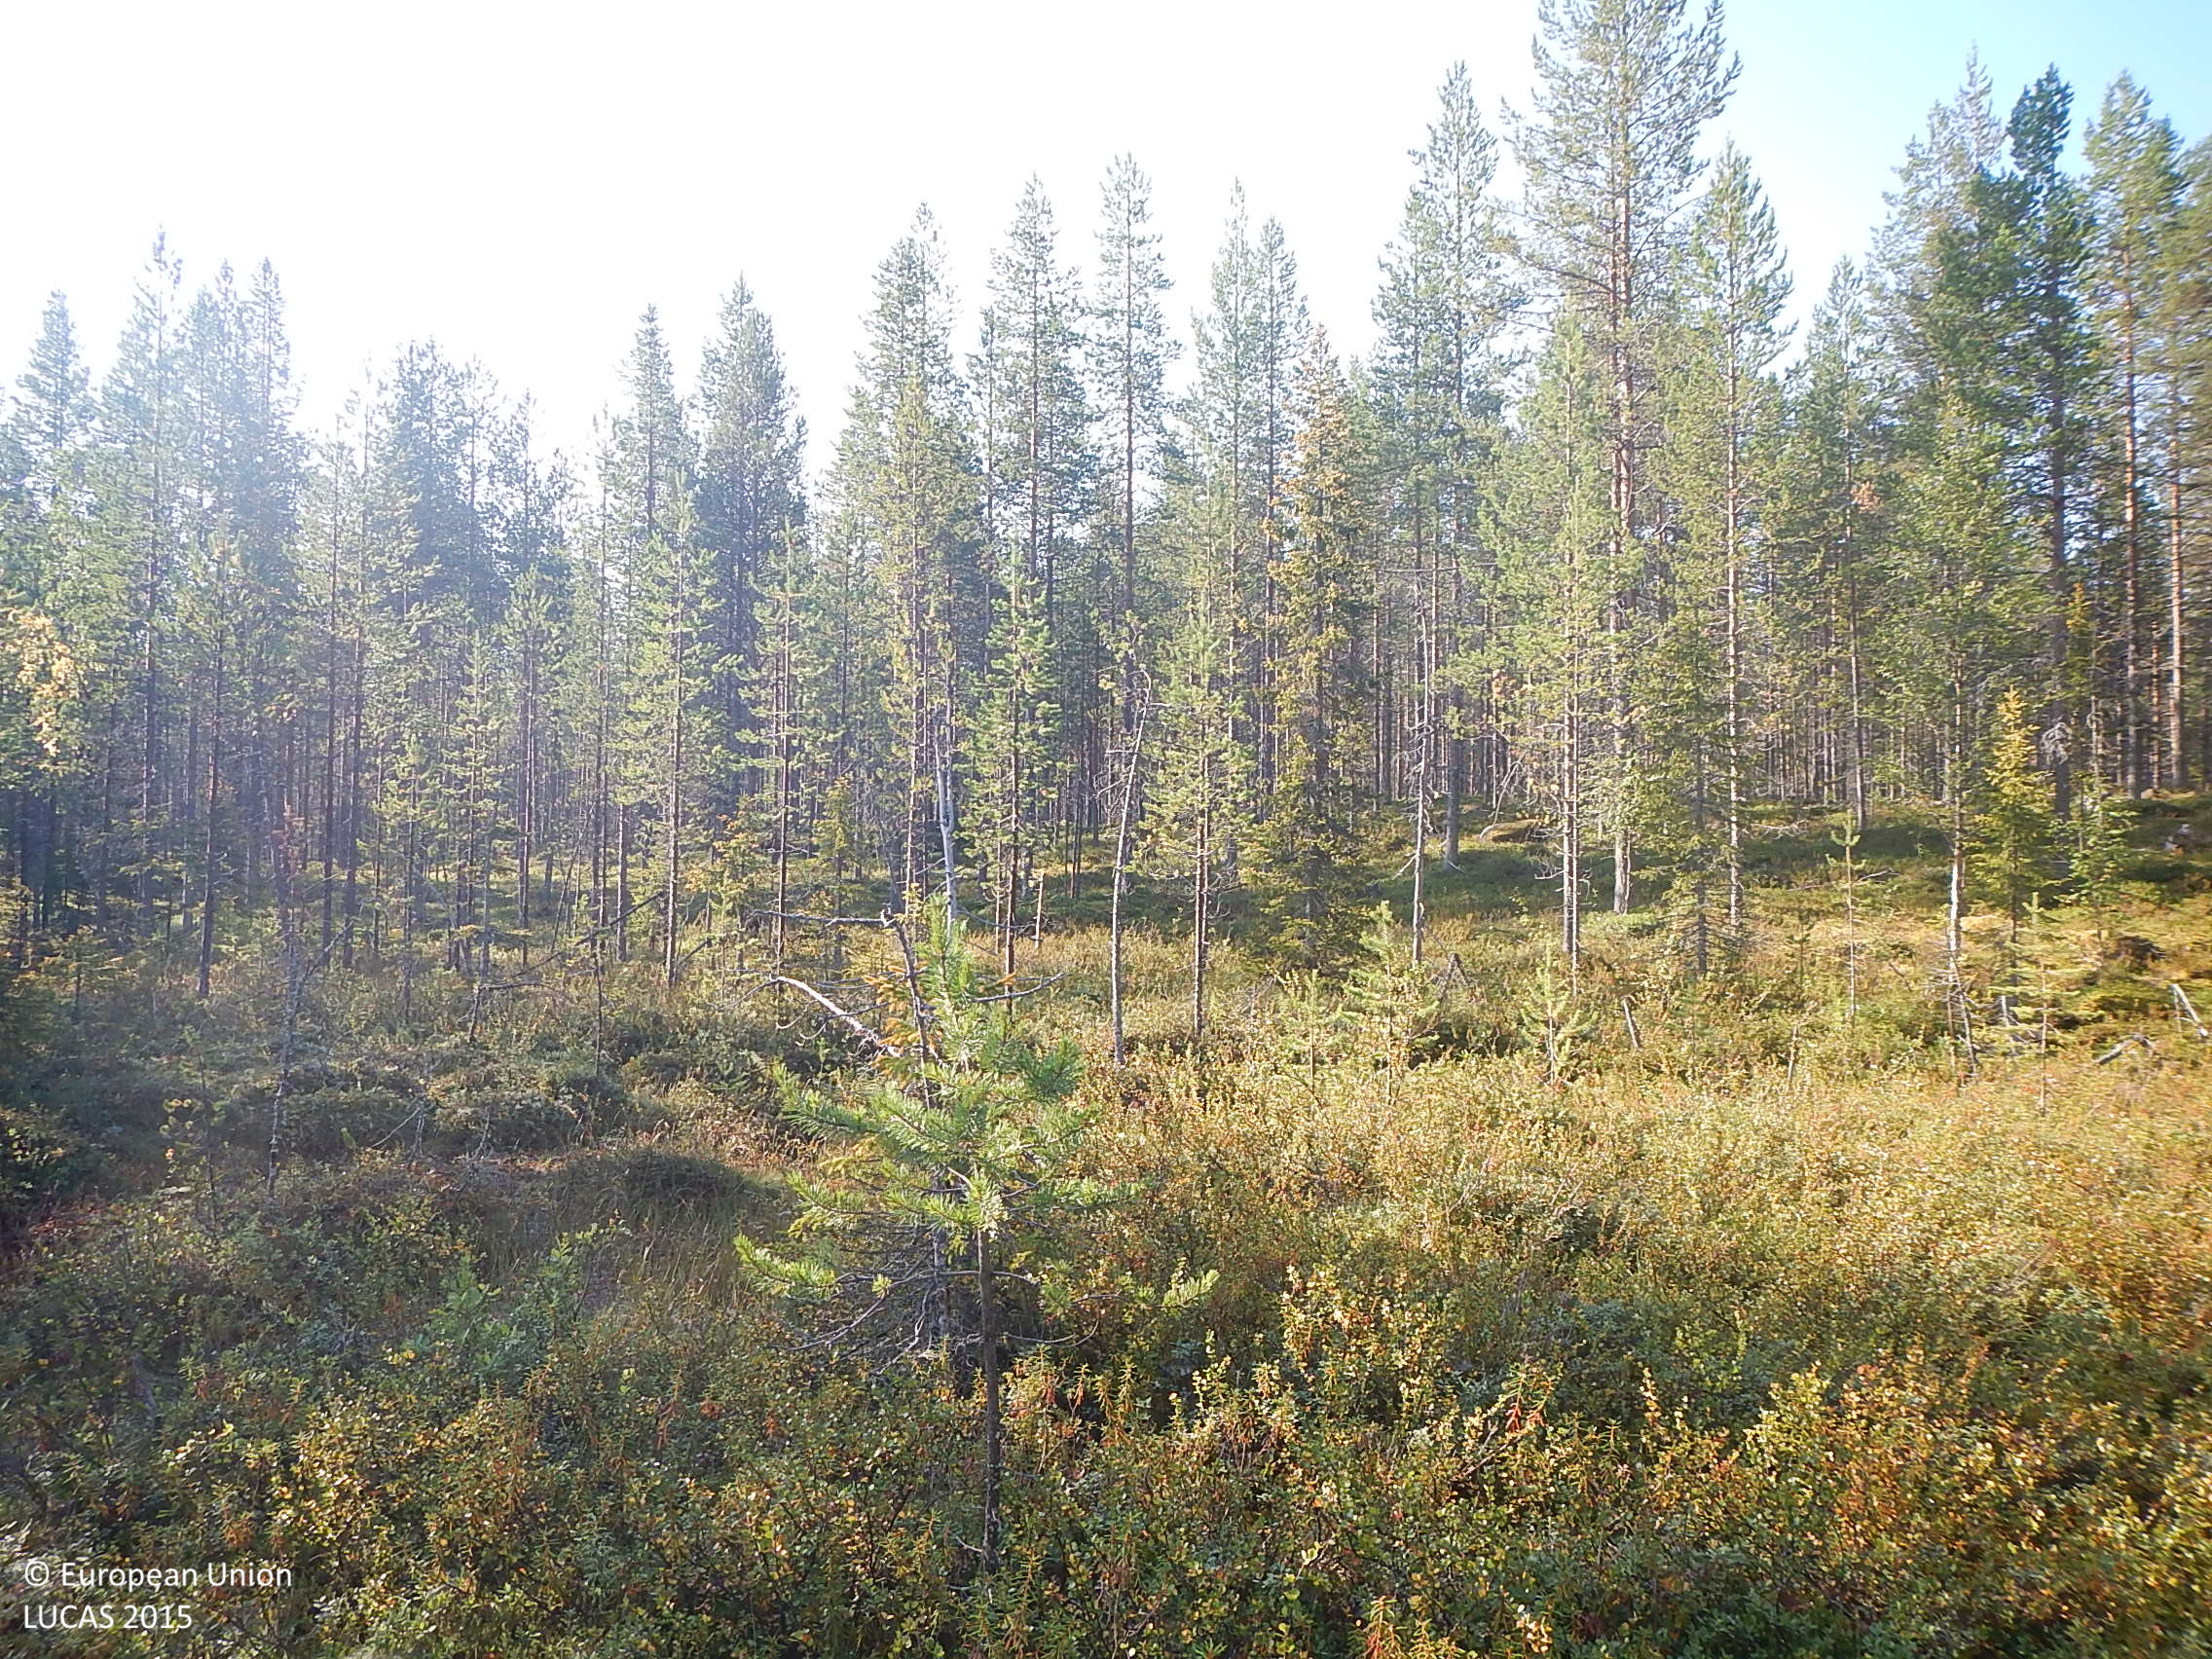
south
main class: Woodland
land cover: Pine dominated coniferous woodland
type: boreal forest
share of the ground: 10 - 25 %
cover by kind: shrubs 70 %, coniferous forest trees 15 %, lichens and mosses 10 %, herbaceous plants 5 %
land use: Forestry
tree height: < 5 m
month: August
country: FI
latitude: 66.4643
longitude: 28.2486
